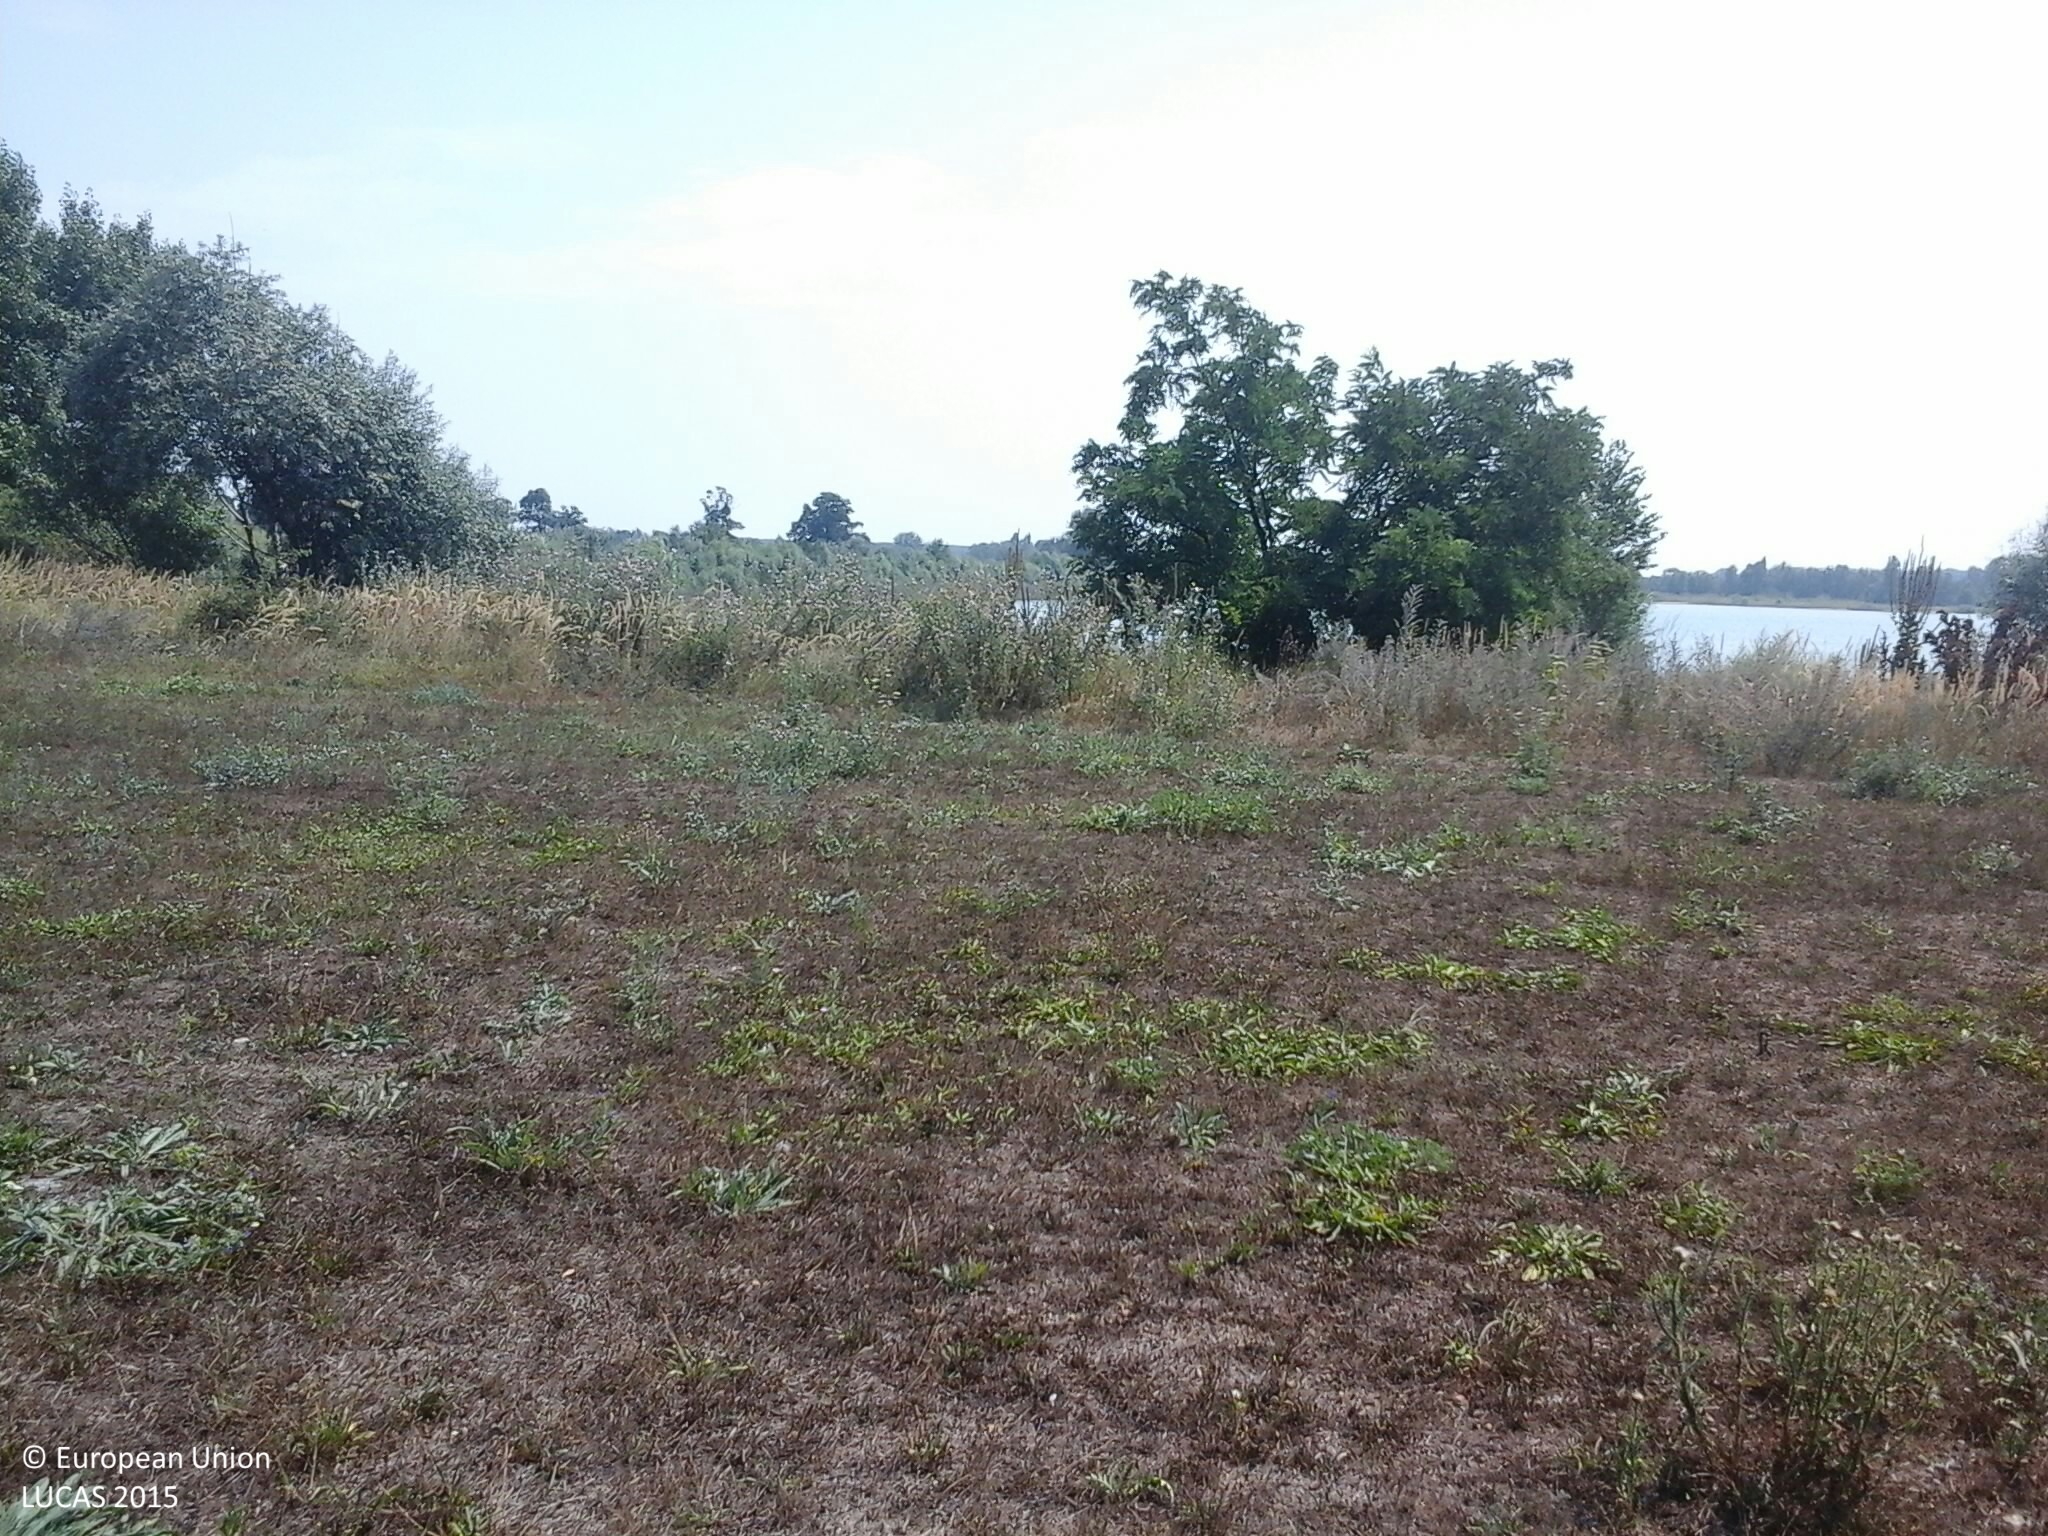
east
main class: Grassland
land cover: Spontaneously vegetated surfaces
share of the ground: > 75 %
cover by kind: herbaceous plants 100 %
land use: Semi-natural and natural areas not in use
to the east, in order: Spontaneously vegetated surfaces; Broadleaved woodland; Fences; Broadleaved woodland; Tracks; Spontaneously vegetated surfaces; Inland fresh water bodies; Broadleaved woodland; Grass margins; Tracks; Spontaneously vegetated surfaces; Ditches and canals; Spontaneously vegetated surfaces; Tracks; Grassland without tree/shrub cover
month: August
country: HU
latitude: 47.3676
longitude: 19.1952
